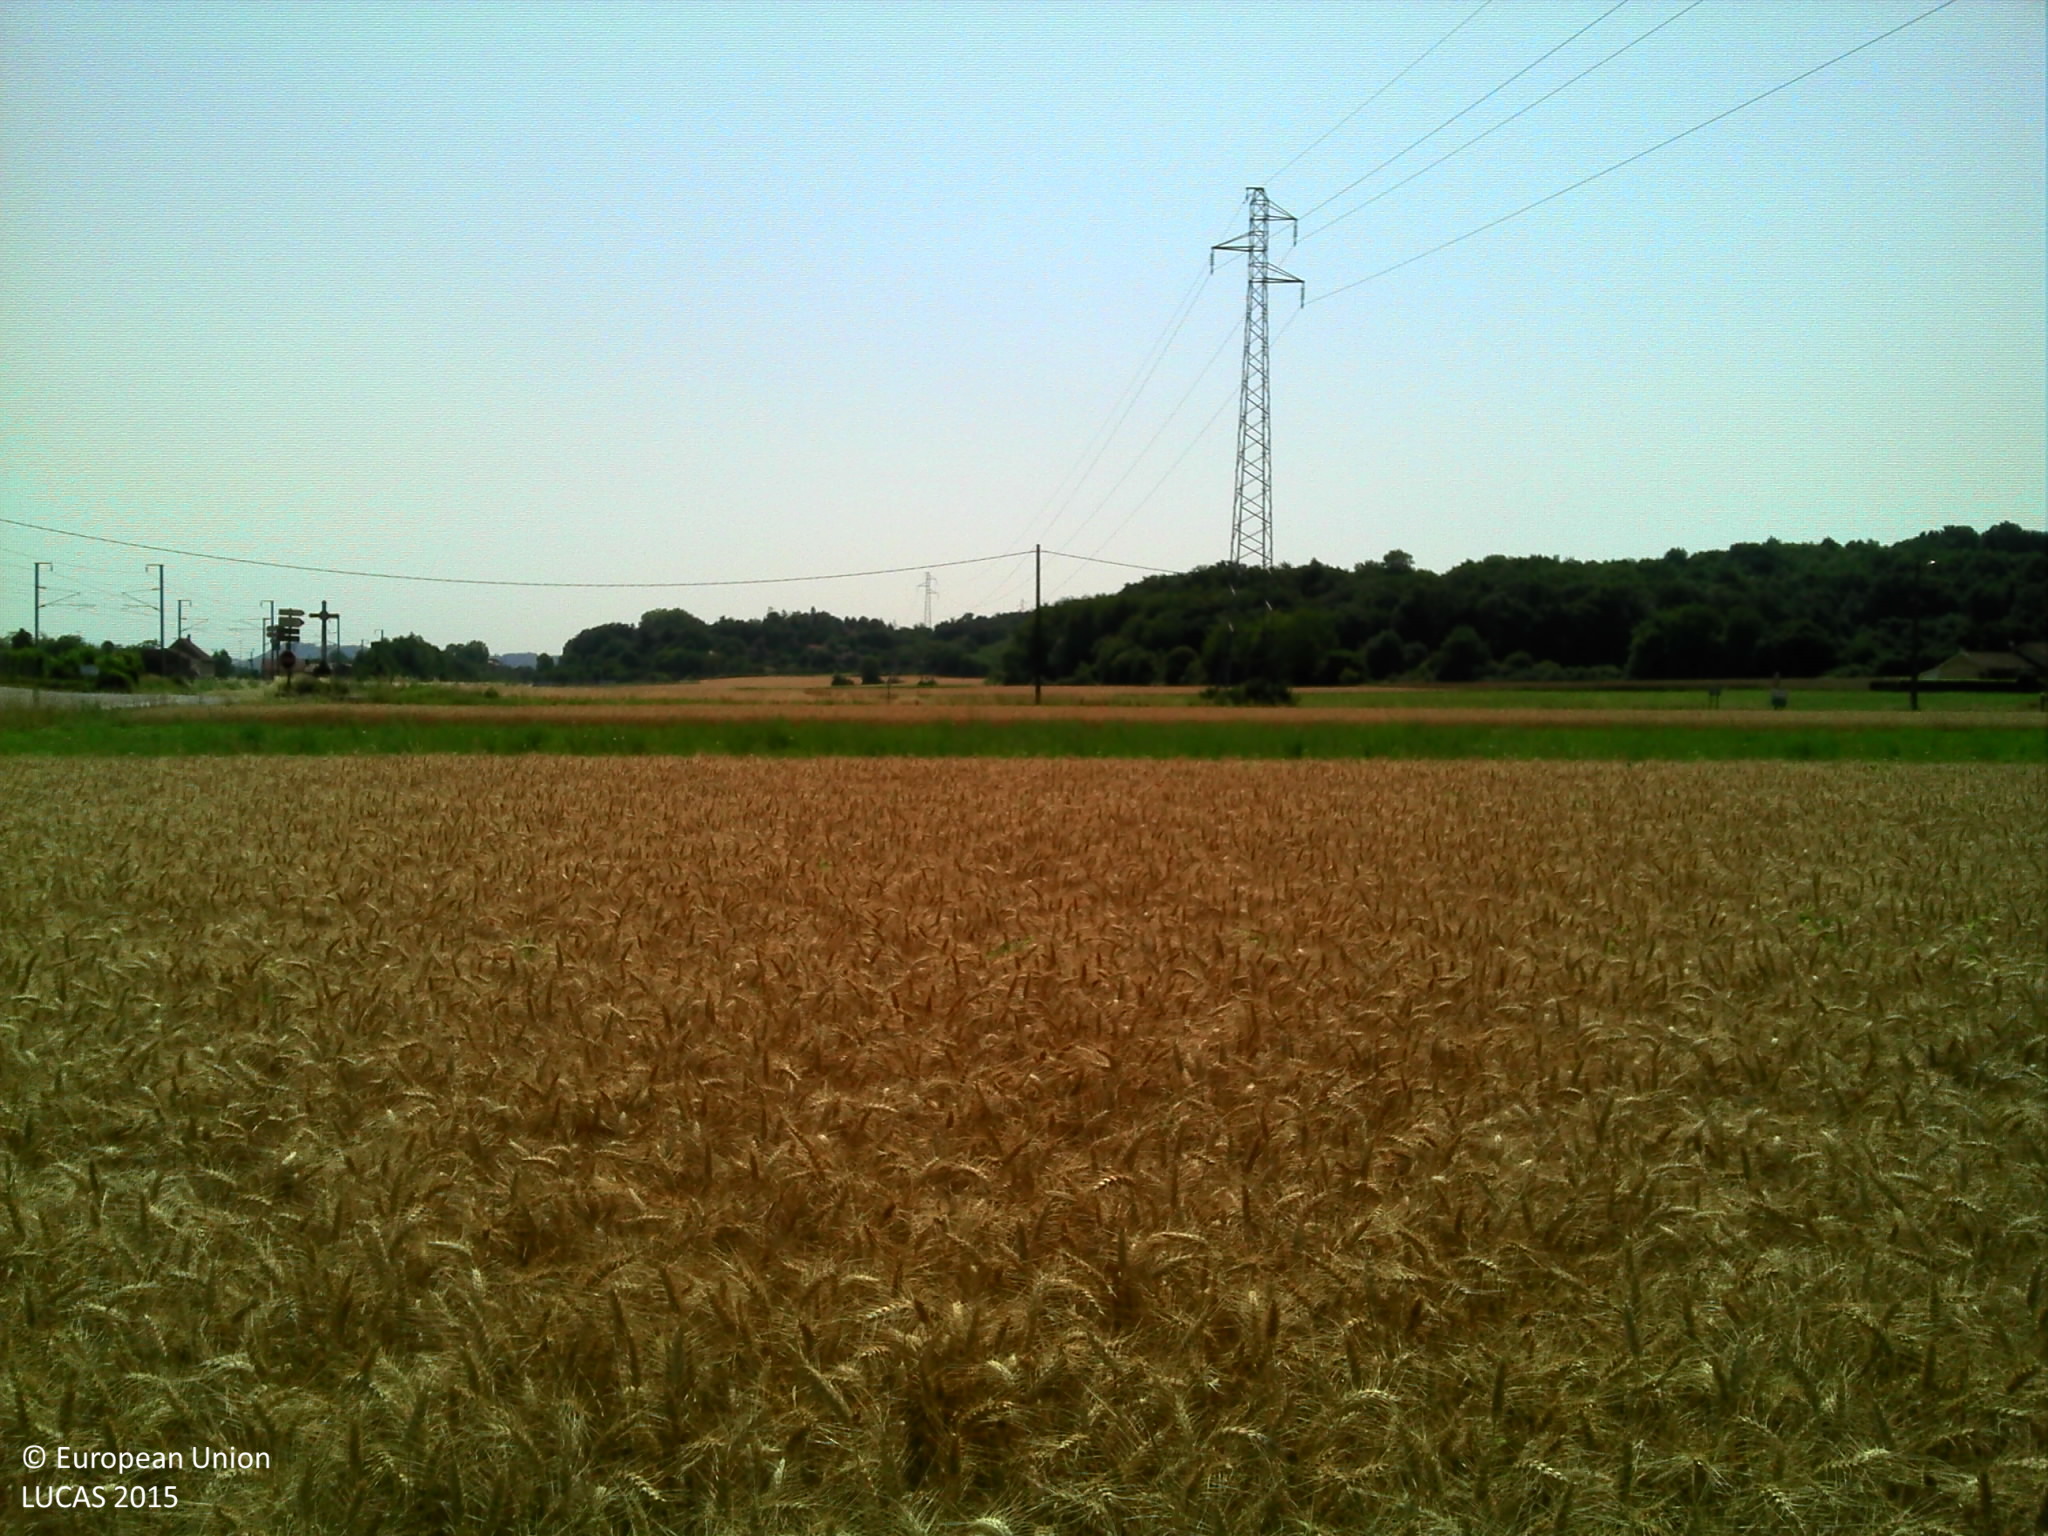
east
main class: Cropland
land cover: Durum wheat
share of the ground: > 75 %
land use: Agriculture (excluding fallow land and kitchen gardens)
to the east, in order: Durum wheat; Grassland without tree/shrub cover; Durum wheat; Grass margins; Paved roads, cycling and walking lanes; Grass margins; Ditches and canals; Electric lines; Durum wheat; Grass margins; Paved roads, cycling and walking lanes; Grass margins
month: July
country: FR
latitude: 45.6117
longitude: 5.1956
